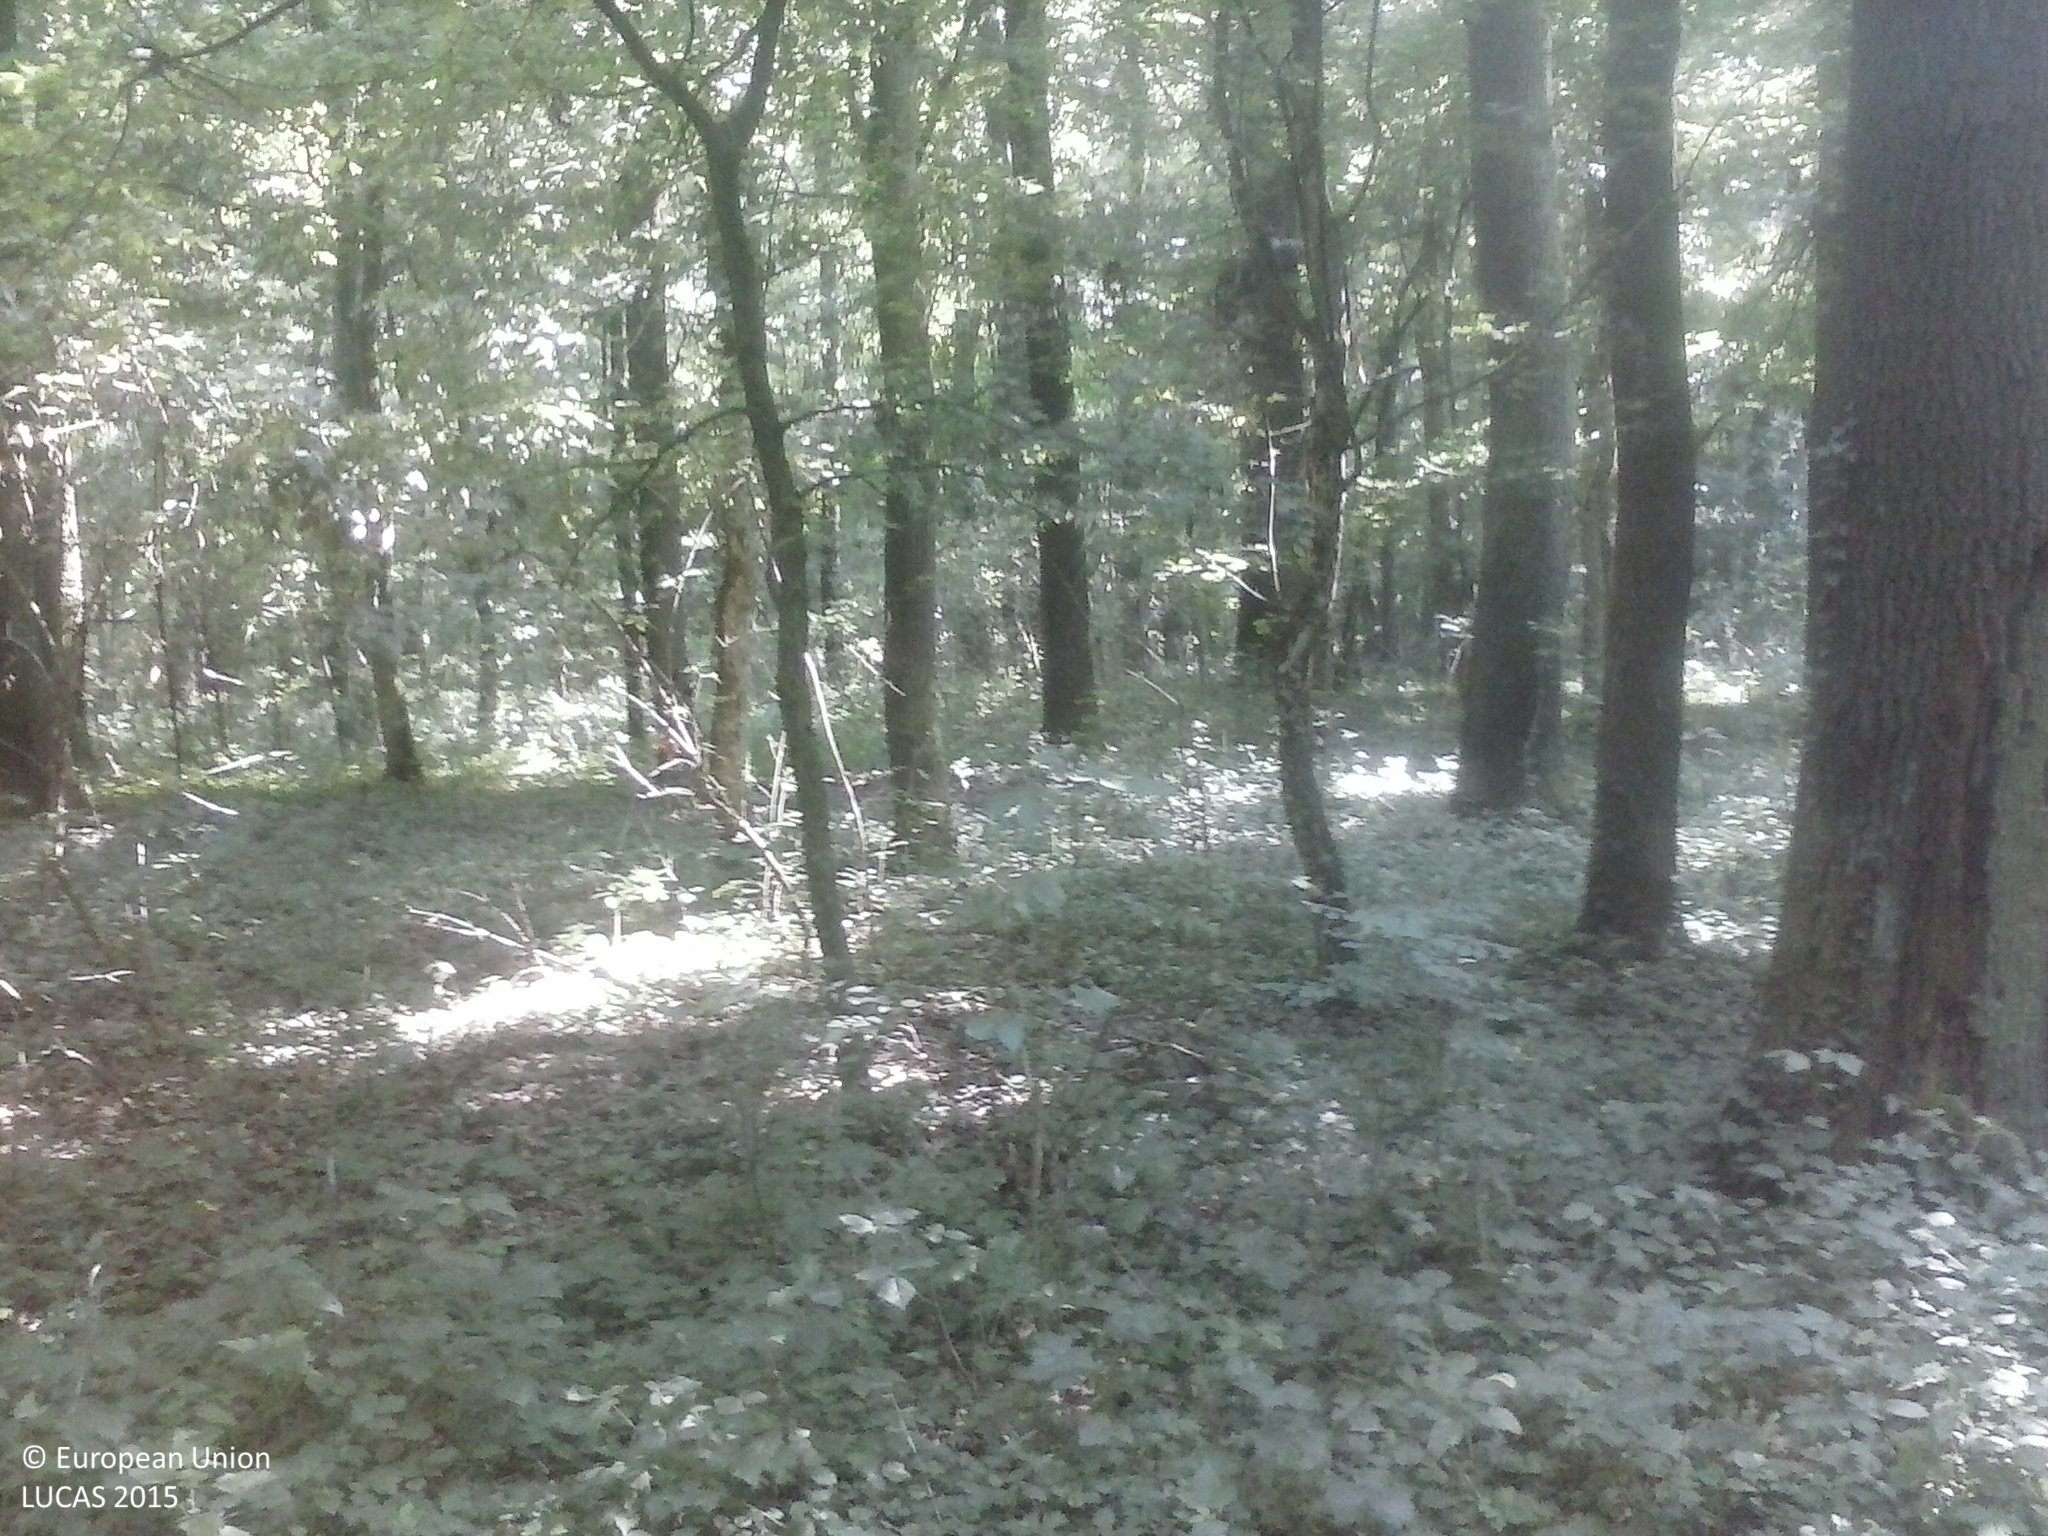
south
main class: Woodland
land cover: Broadleaved woodland
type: mesophytic deciduous forest
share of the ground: > 75 %
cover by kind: broadleaved forest trees 90 %, shrubs 5 %, herbaceous plants 5 %
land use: Forestry
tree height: > 5 m
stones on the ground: < 10 %
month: August
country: HU
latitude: 45.9926
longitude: 17.8157
